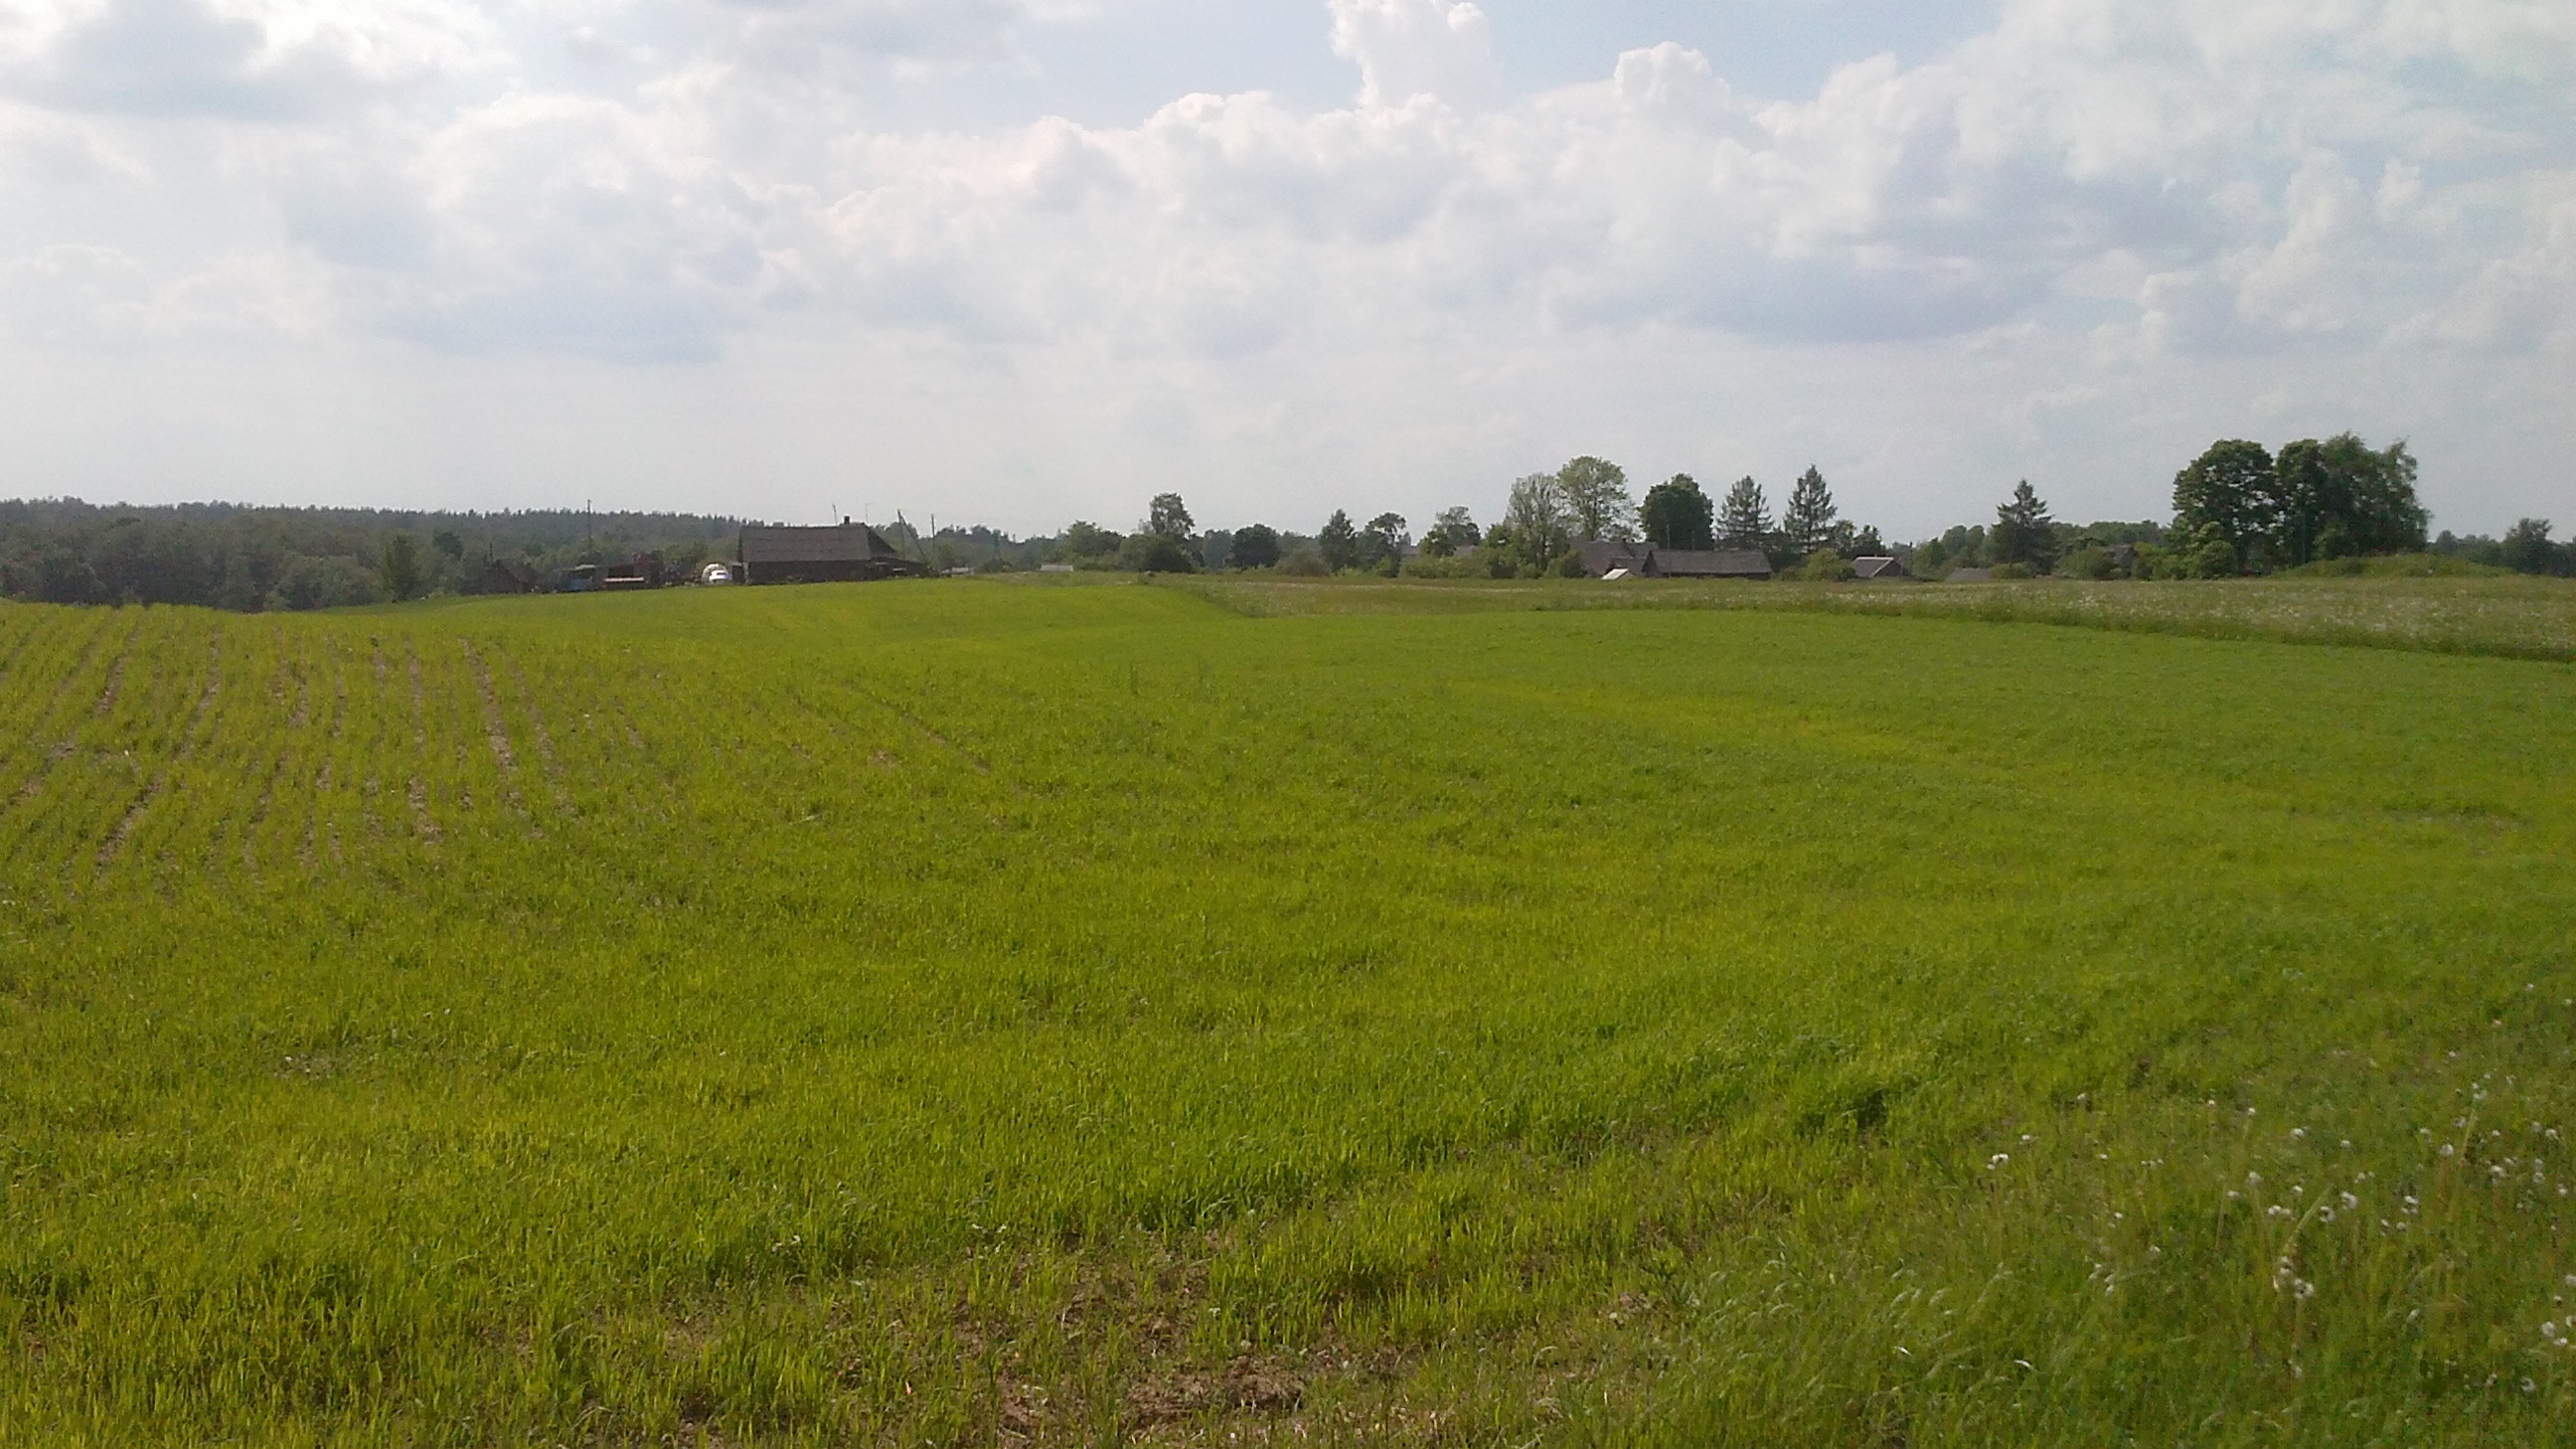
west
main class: Cropland
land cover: Oats
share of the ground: > 75 %
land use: Agriculture (excluding fallow land and kitchen gardens)
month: June
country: LV
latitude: 56.2127
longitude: 28.1151
